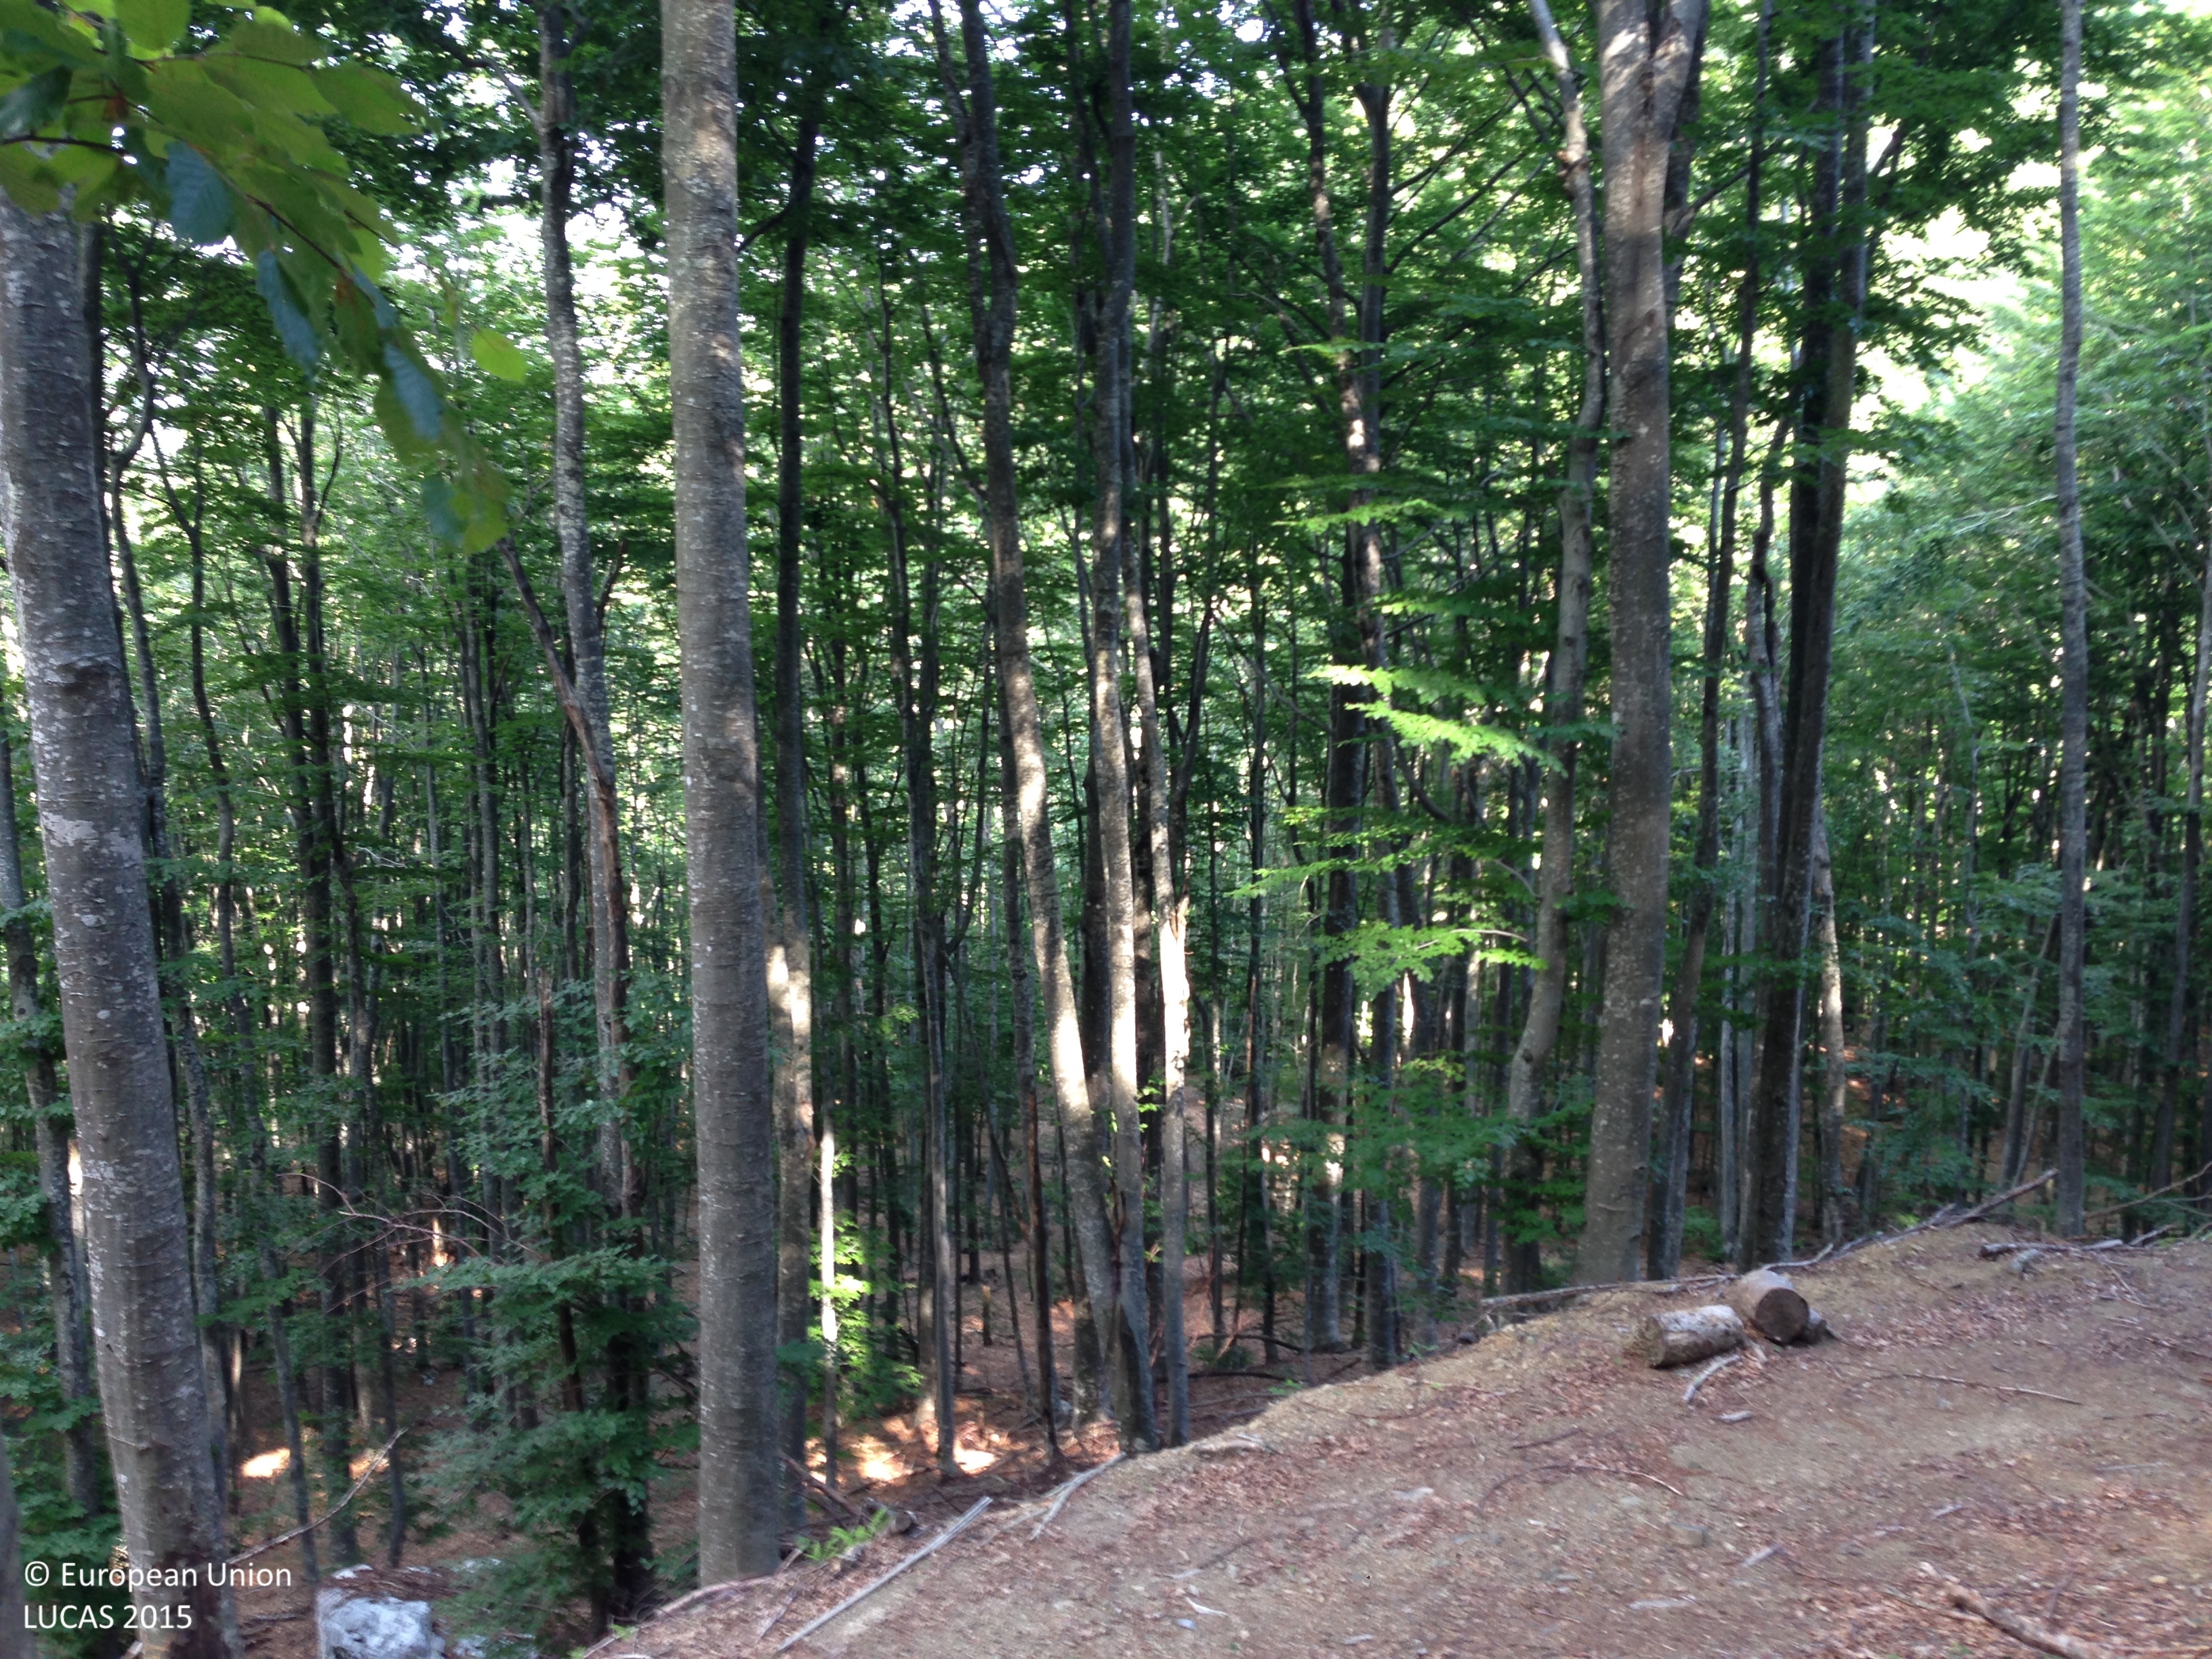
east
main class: Woodland
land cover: Other mixed woodland
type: mountainous beech forest
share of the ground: > 75 %
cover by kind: broadleaved forest trees 60 %, coniferous forest trees 20 %, lichens and mosses 10 %, shrubs 5 %, unconsolidated bare surface 5 %
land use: Forestry
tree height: > 5 m
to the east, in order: Other mixed woodland; Tracks; Other mixed woodland; Tracks; Other mixed woodland; Rivers and streams; Other mixed woodland; Rivers and streams; Other mixed woodland; Rivers and streams; Other mixed woodland; Rivers and streams; Other mixed woodland
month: July
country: HR
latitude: 44.6203
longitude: 15.1480
